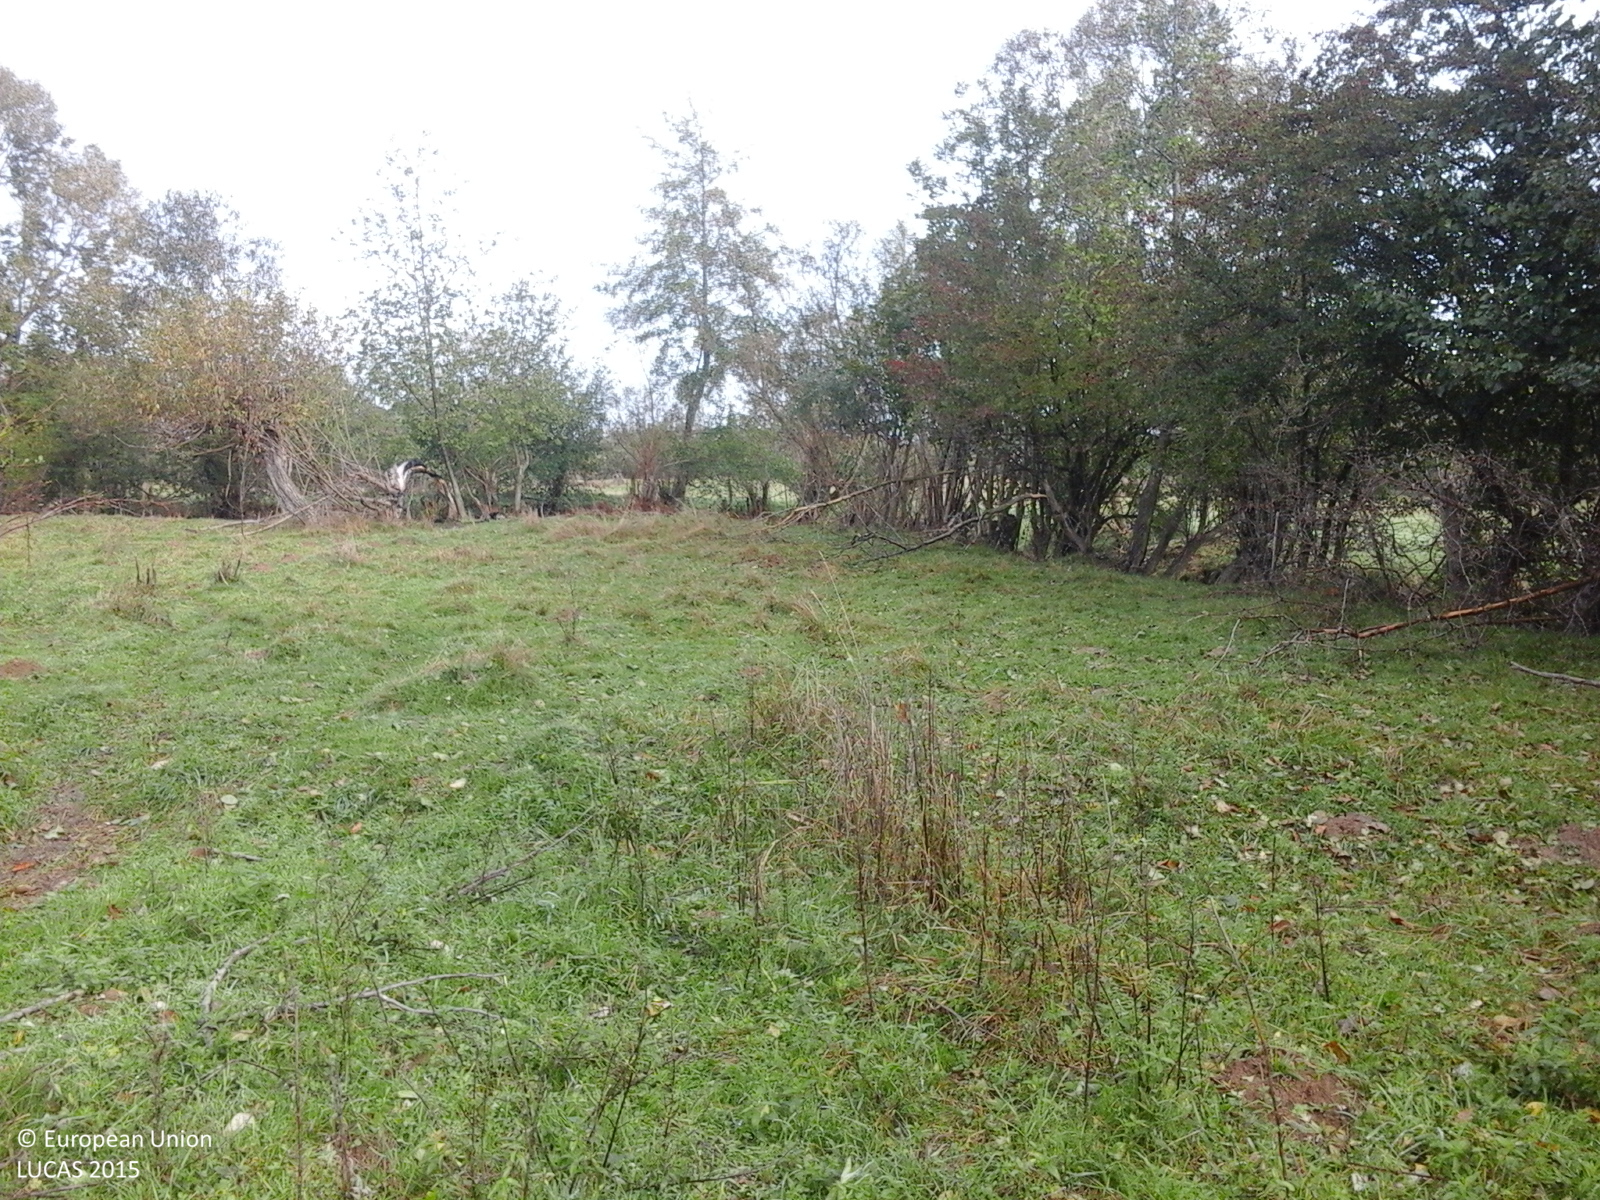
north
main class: Grassland
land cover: Grassland with sparse tree/shrub cover
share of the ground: > 75 %
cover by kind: herbaceous plants 90 %, broadleaved forest trees 5 %, shrubs 5 %
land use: Agriculture (excluding fallow land and kitchen gardens)
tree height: > 5 m
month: October
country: RO
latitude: 45.7241
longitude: 25.0091
